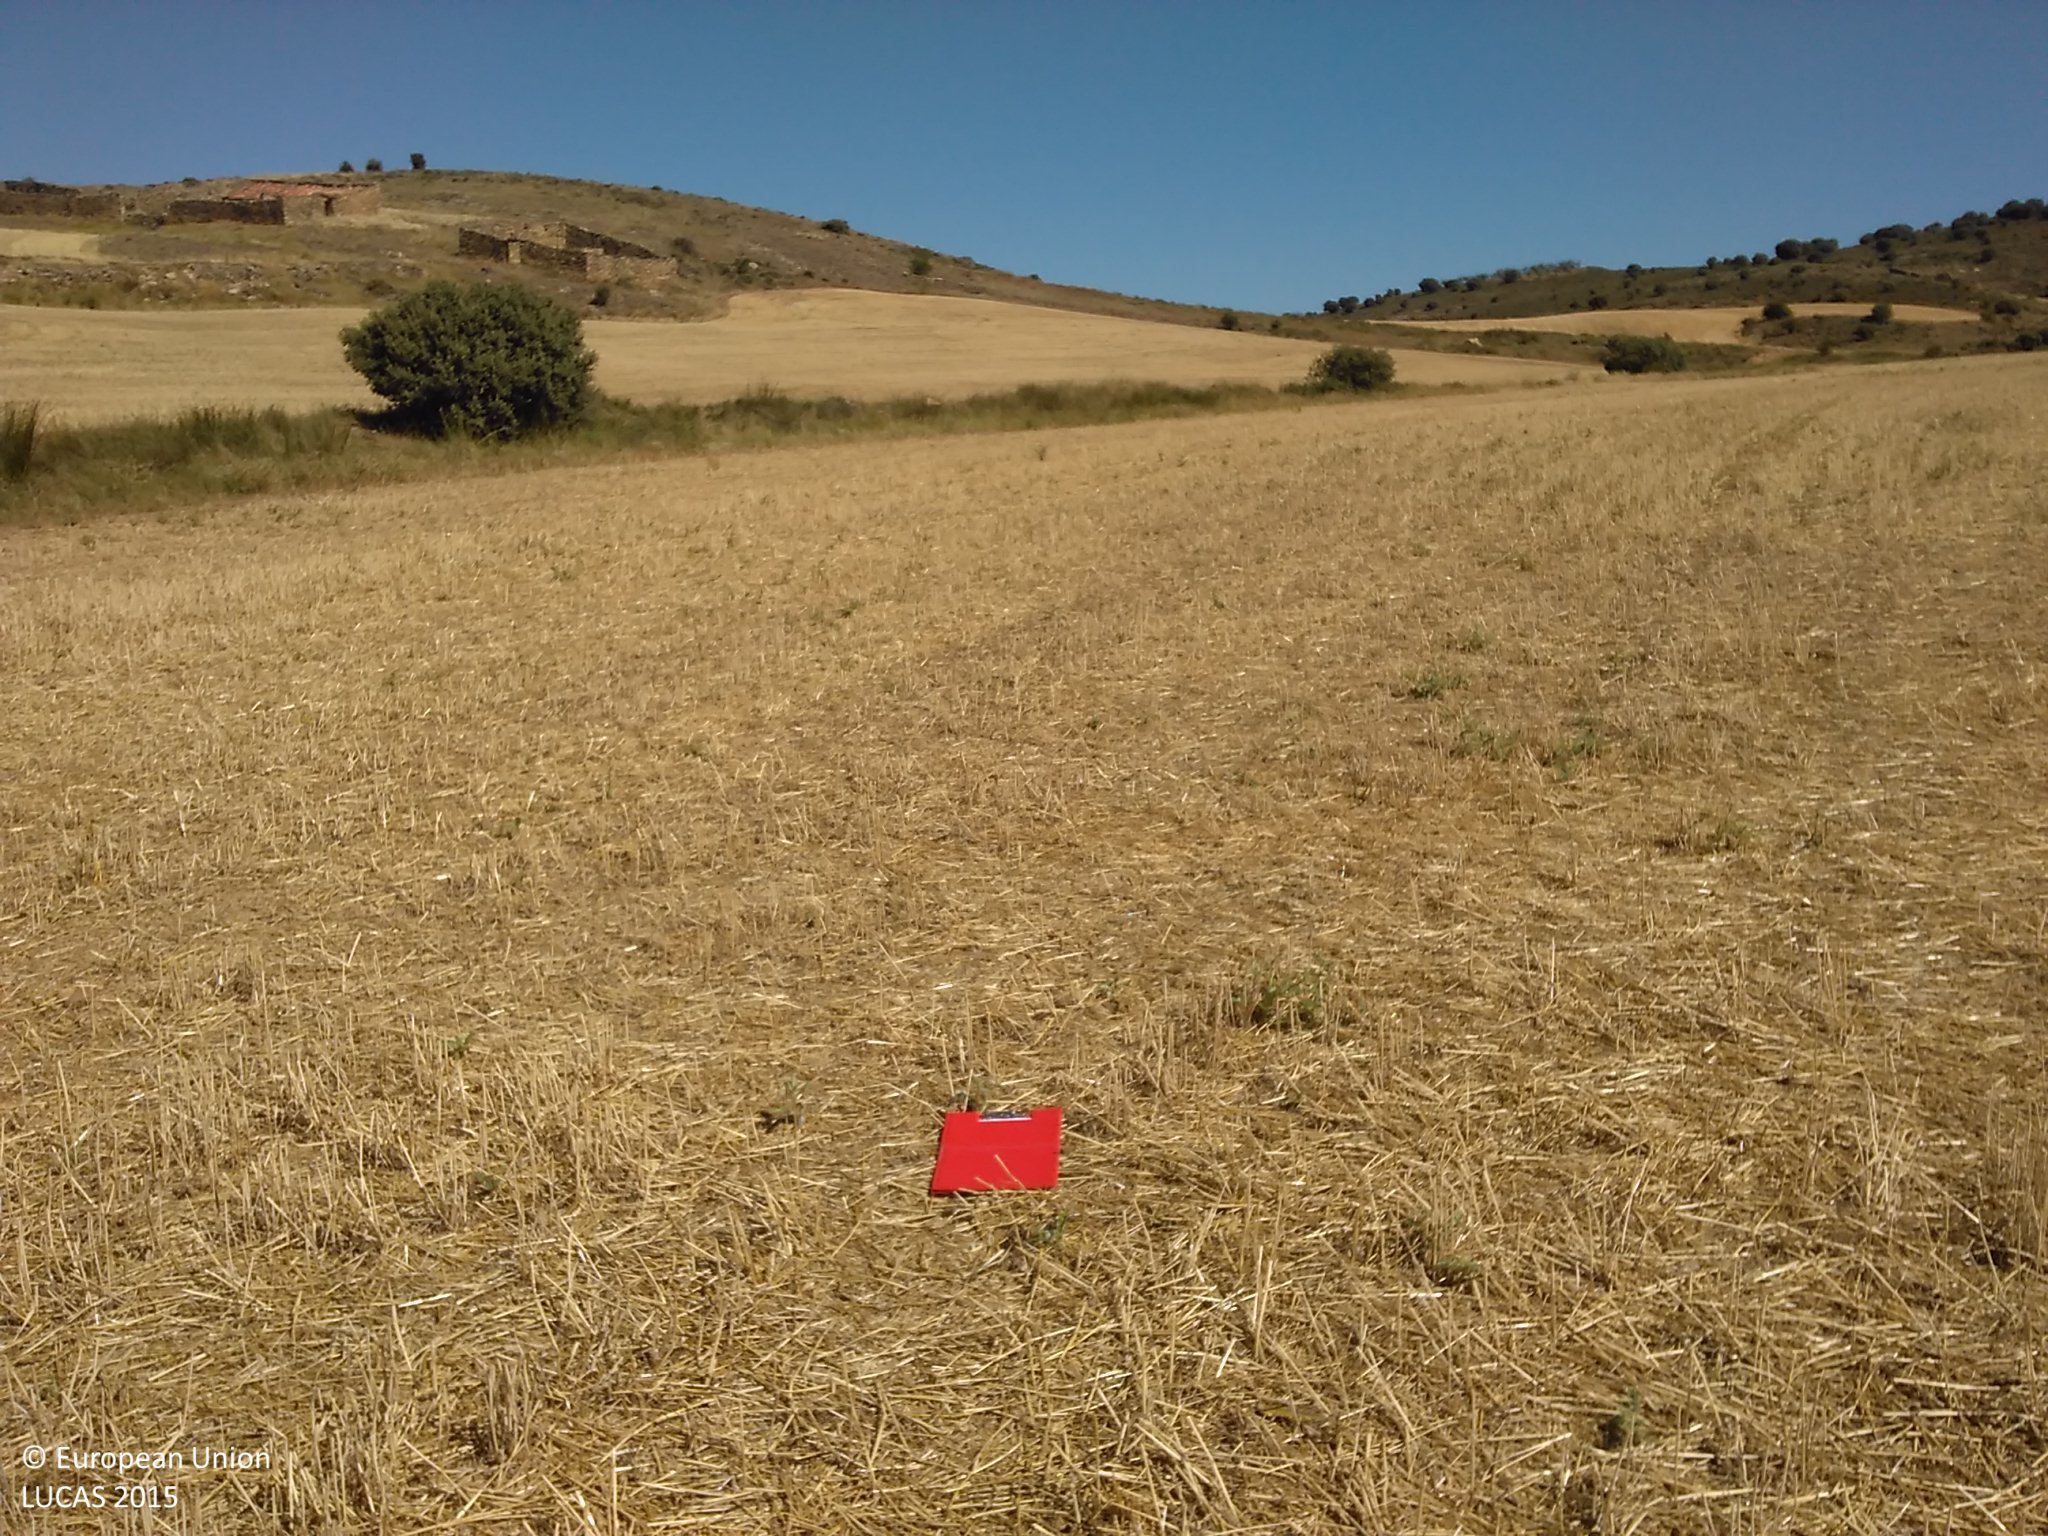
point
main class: Cropland
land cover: Common wheat
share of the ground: < 10 %
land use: Agriculture (excluding fallow land and kitchen gardens)
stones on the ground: < 10 %
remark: Harvested field
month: July
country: ES
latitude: 41.5566
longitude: -1.9846
